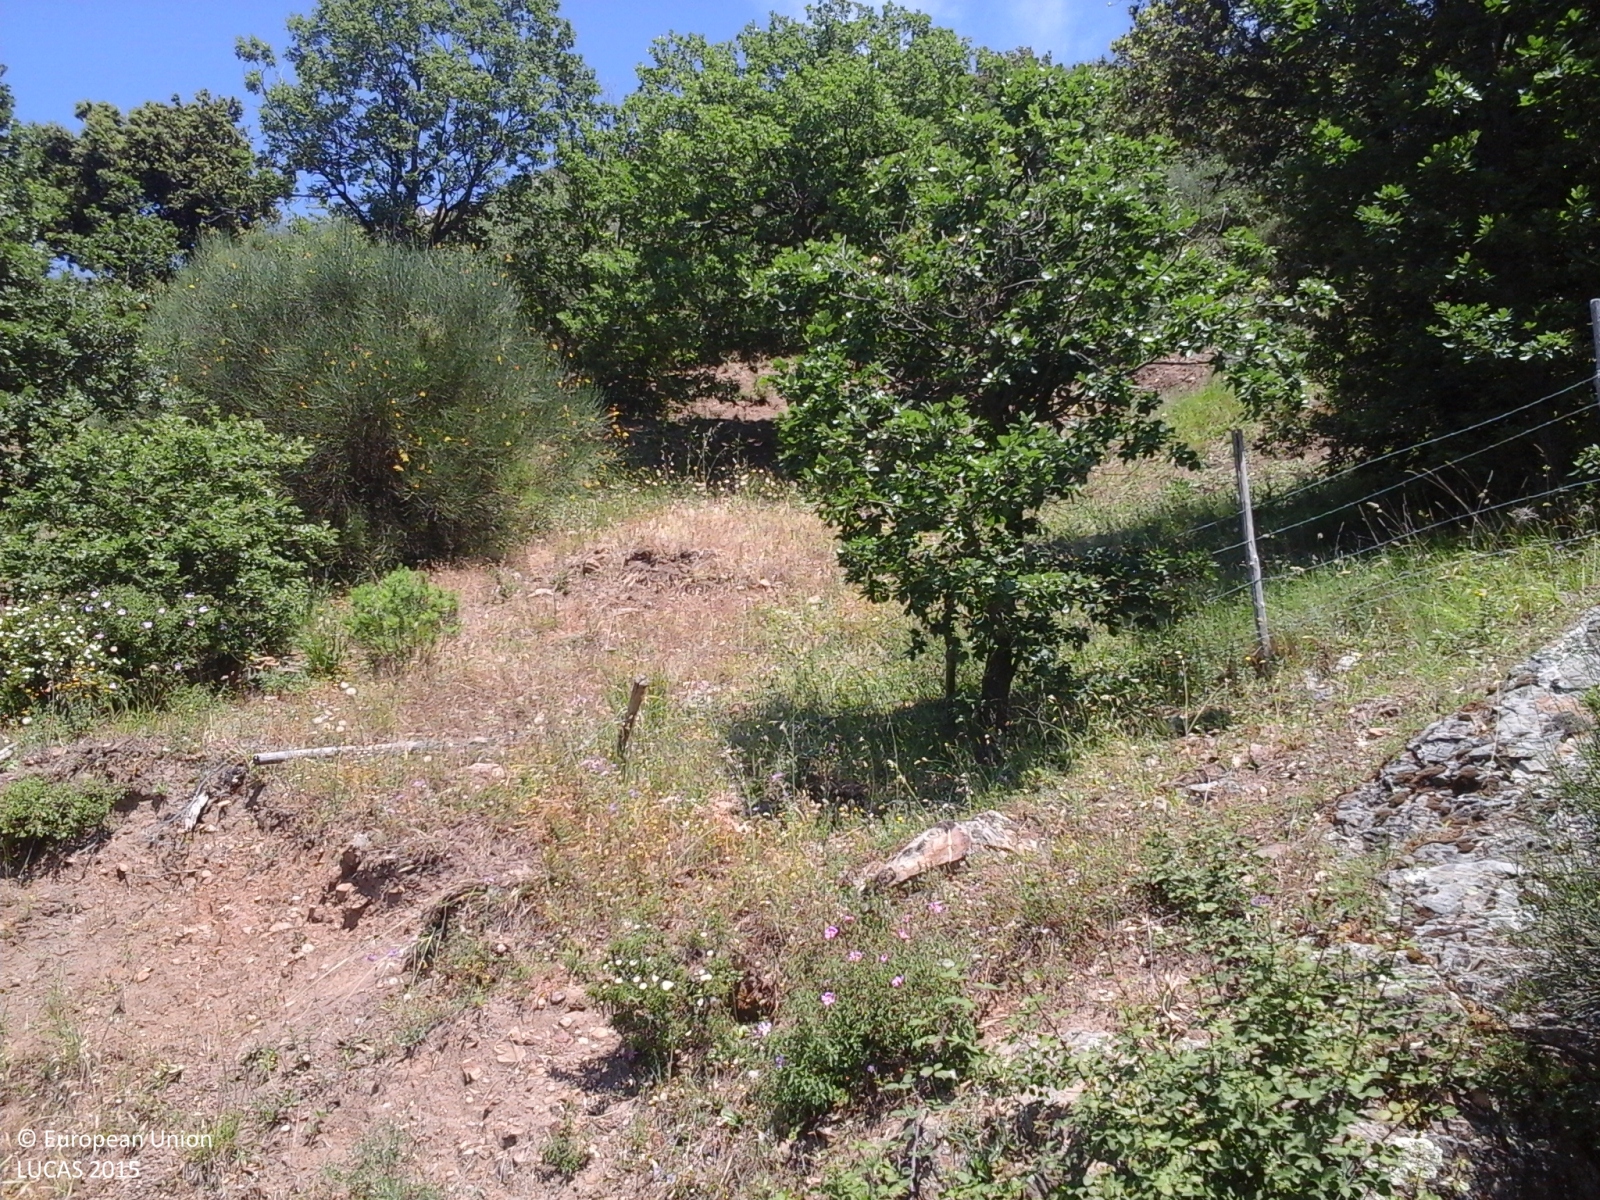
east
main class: Shrubland
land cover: Shrubland with sparse tree cover
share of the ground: > 75 %
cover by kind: shrubs 55 %, herbaceous plants 40 %, broadleaved forest trees 5 %
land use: Agriculture (excluding fallow land and kitchen gardens)
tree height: < 5 m
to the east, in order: Shrubland with sparse tree cover; Grassland with sparse tree/shrub cover; Rocks and stones
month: June
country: IT
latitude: 37.9555
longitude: 13.9669
